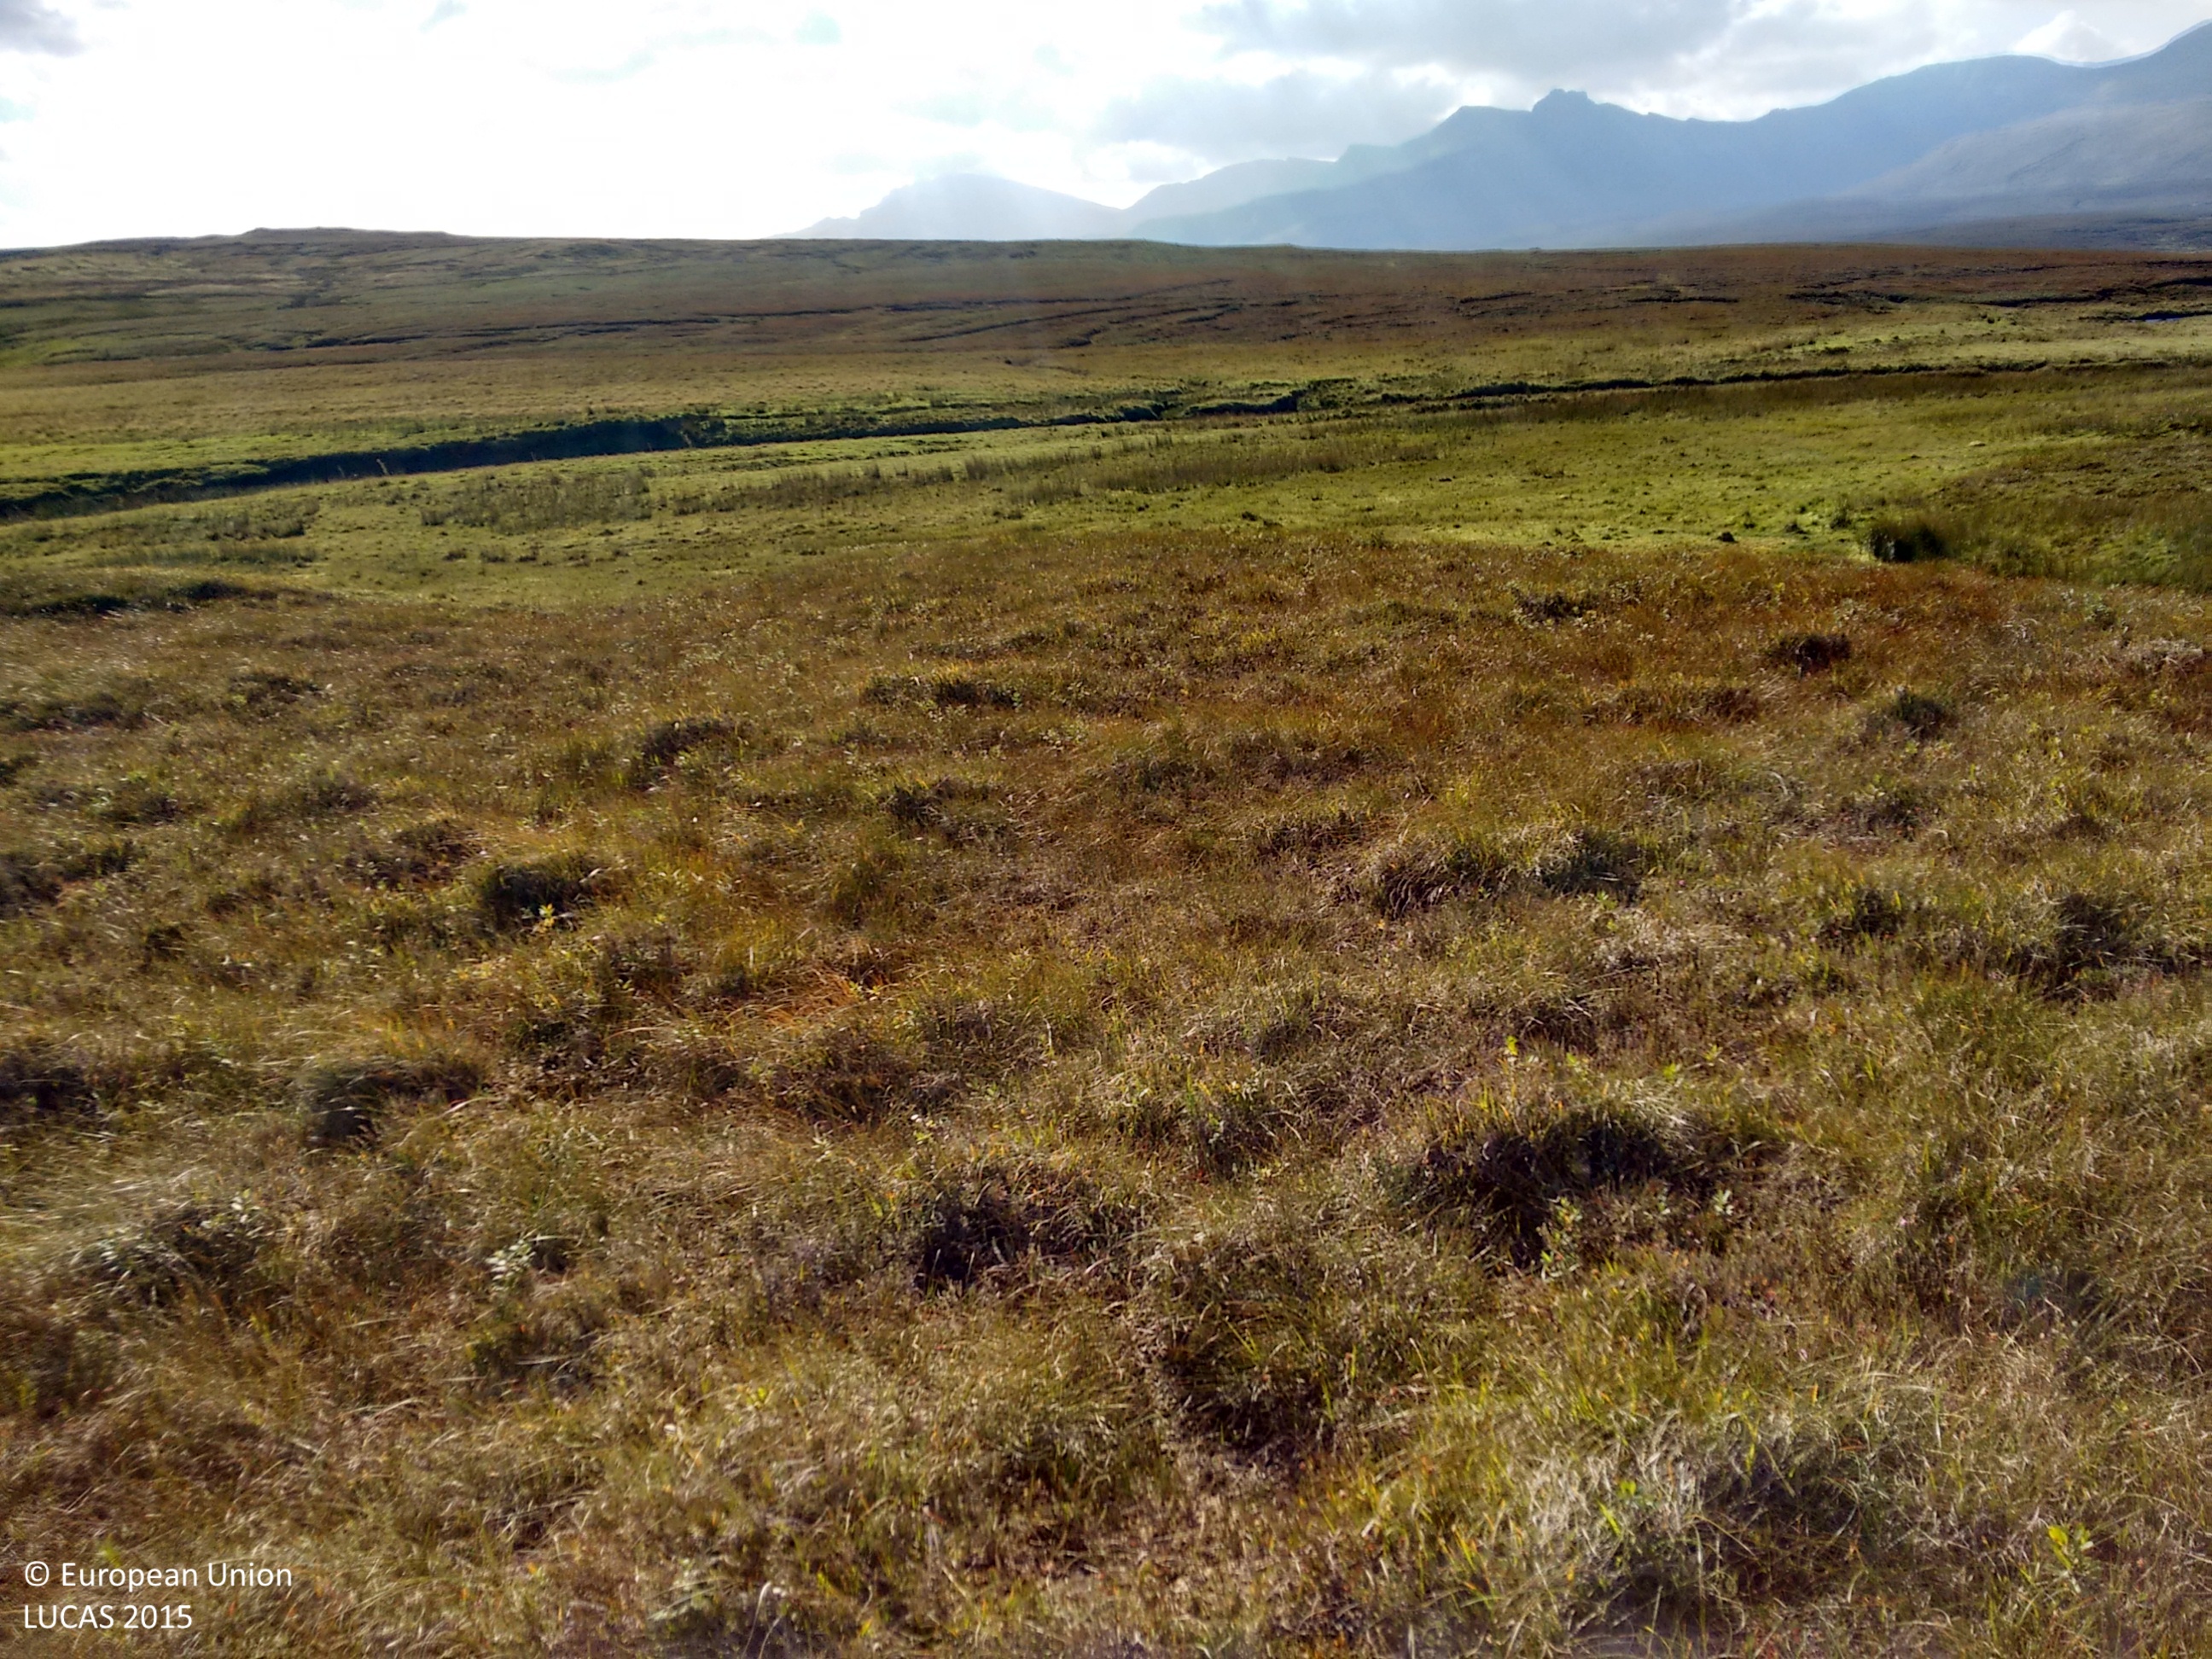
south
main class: Shrubland
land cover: Shrubland without tree cover
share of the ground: > 75 %
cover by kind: herbaceous plants 65 %, shrubs 30 %, lichens and mosses 5 %
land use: Agriculture (excluding fallow land and kitchen gardens)
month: September
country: GB
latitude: 57.5932
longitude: -6.2111
